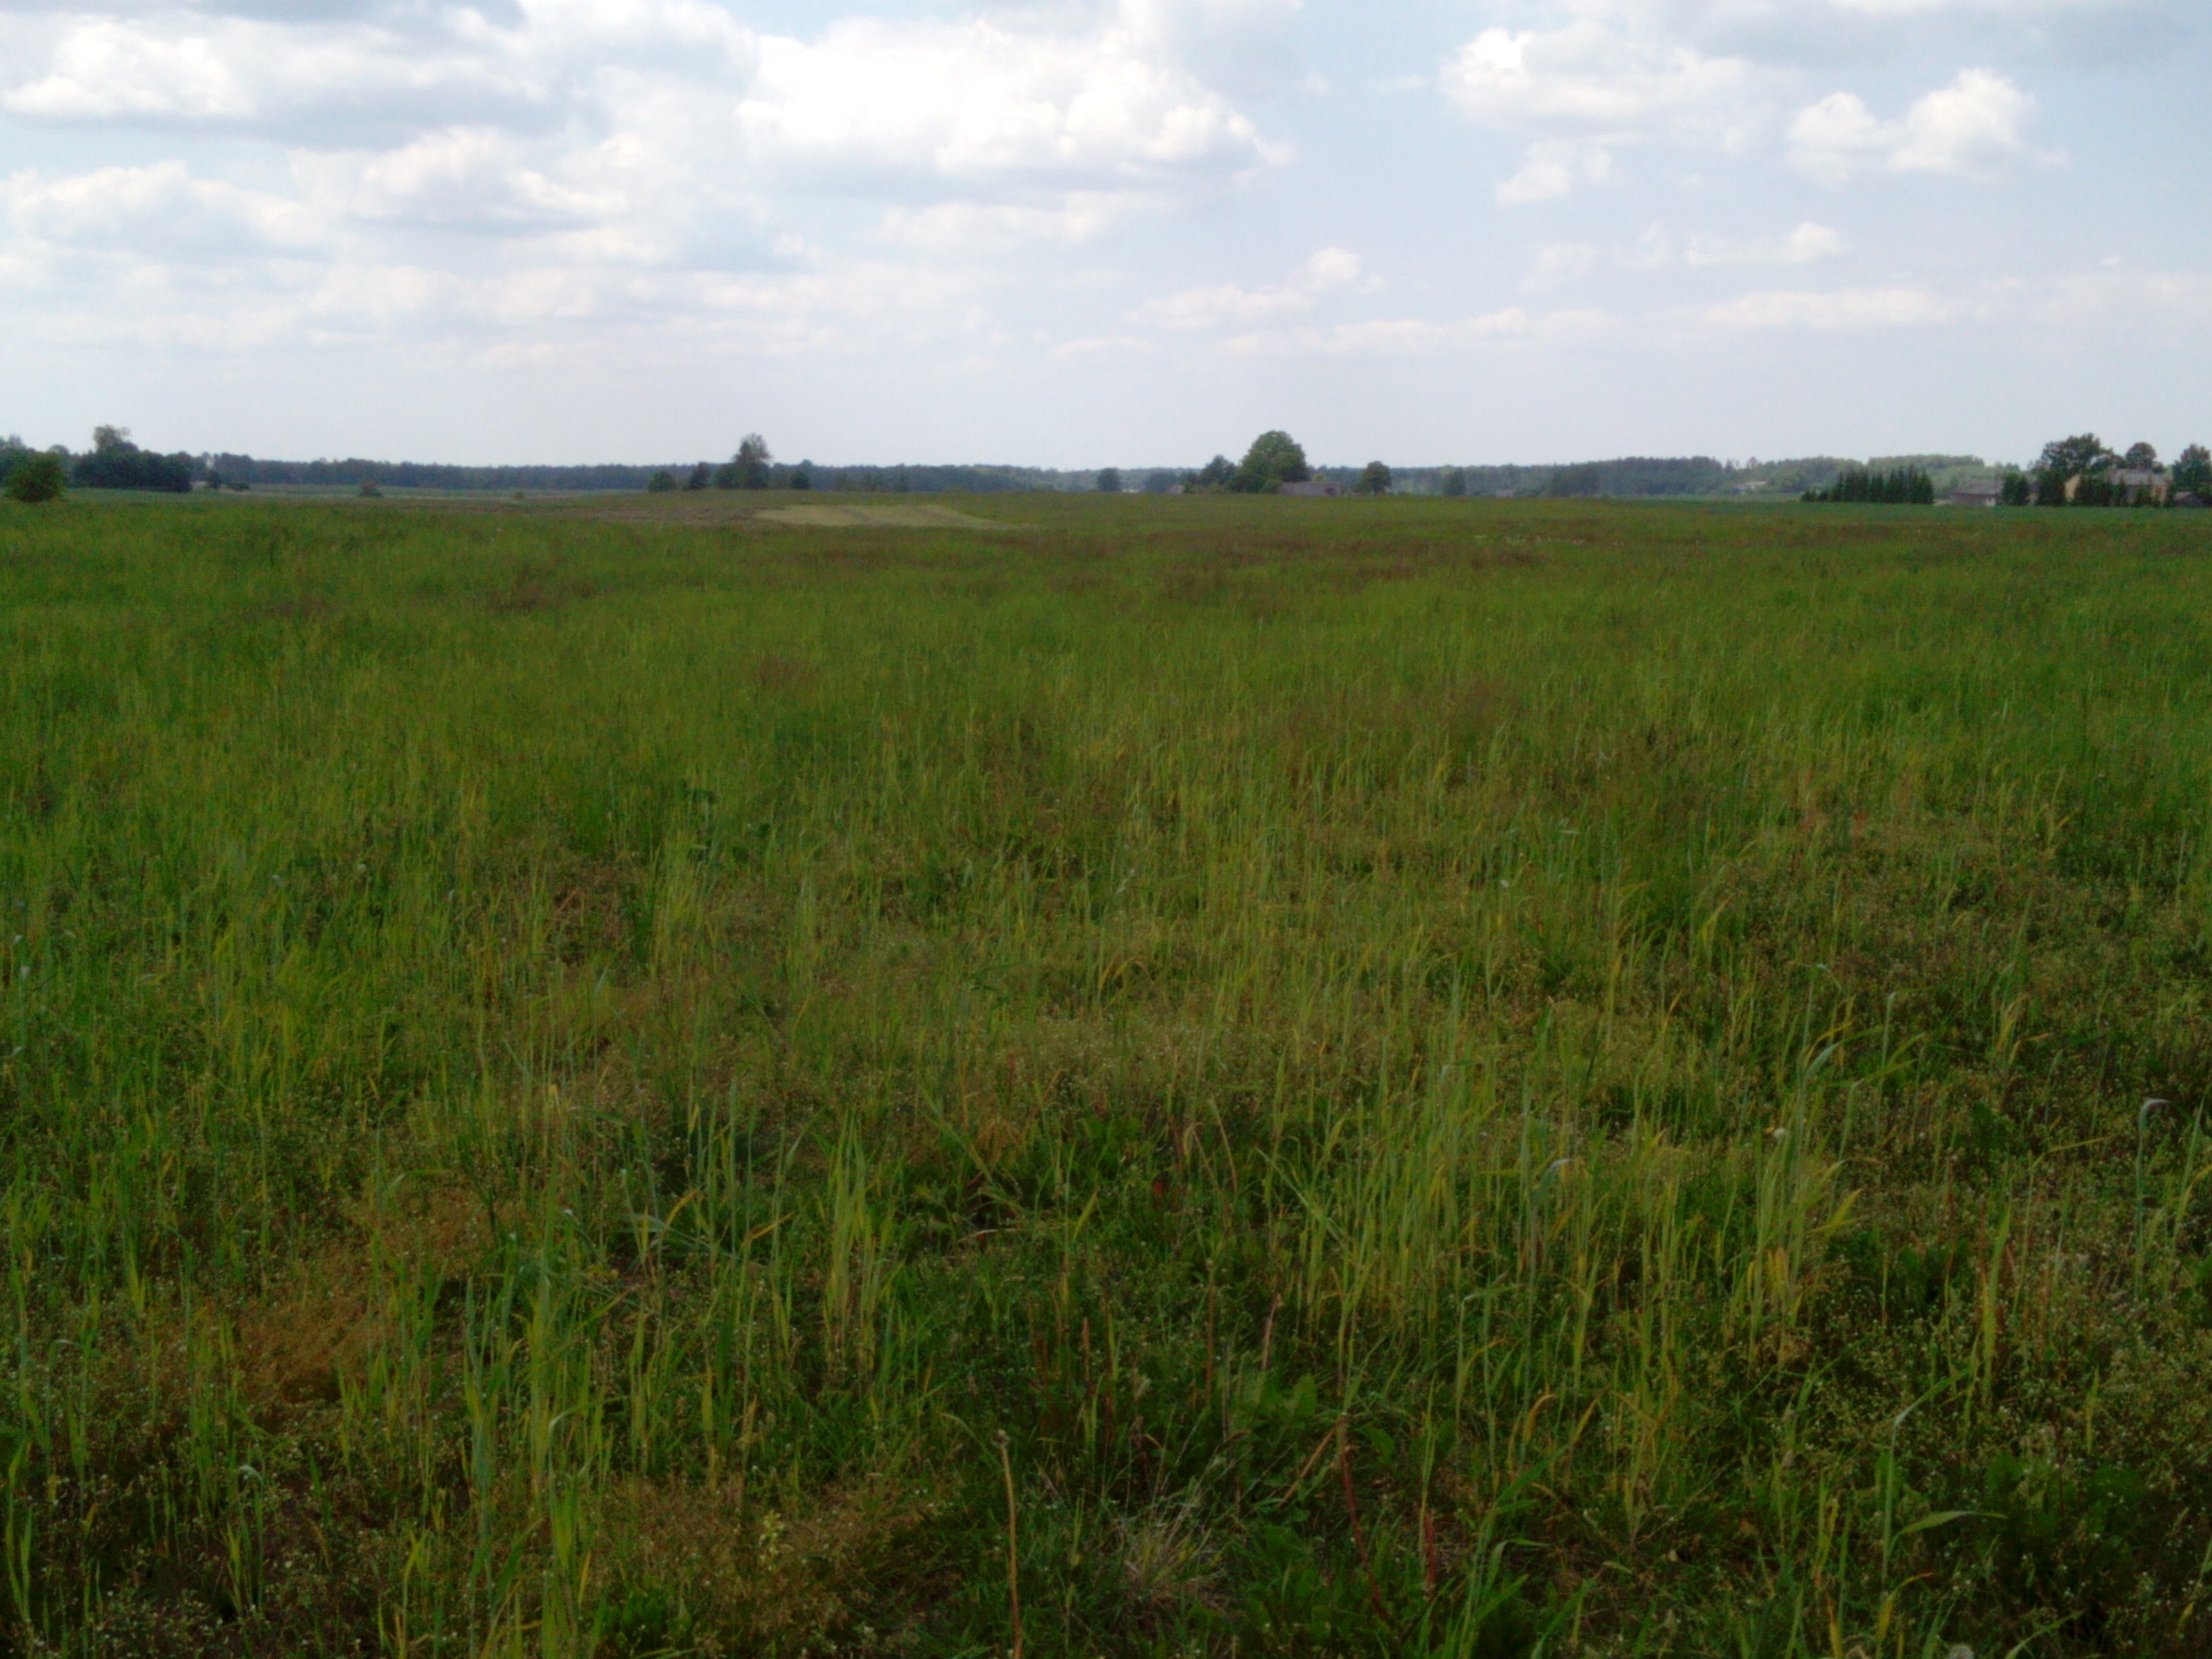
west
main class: Grassland
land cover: Grassland without tree/shrub cover
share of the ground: > 75 %
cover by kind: herbaceous plants 100 %
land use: Agriculture (excluding fallow land and kitchen gardens)
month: June
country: LV
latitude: 56.8146
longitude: 22.2894
